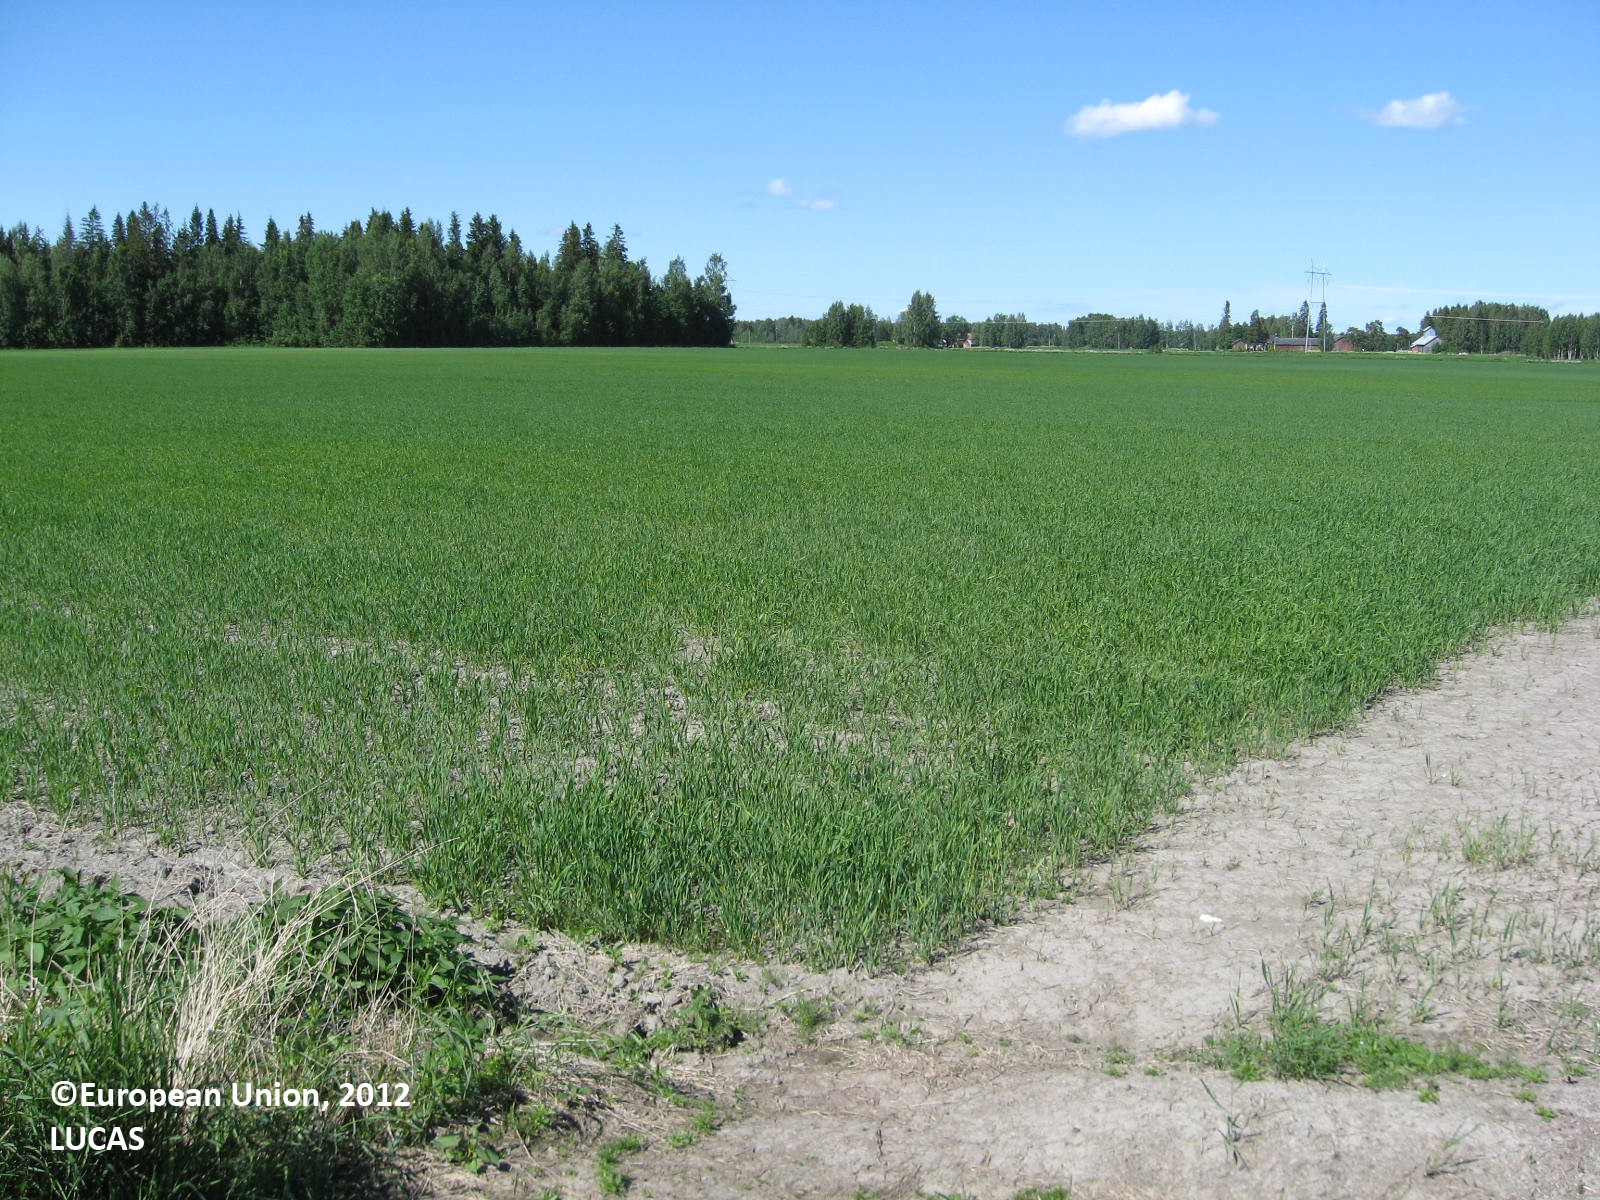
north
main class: Cropland
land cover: Temporary grasslands
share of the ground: > 75 %
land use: Agriculture (excluding fallow land and kitchen gardens)
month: June
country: FI
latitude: 62.8103
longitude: 22.6292
